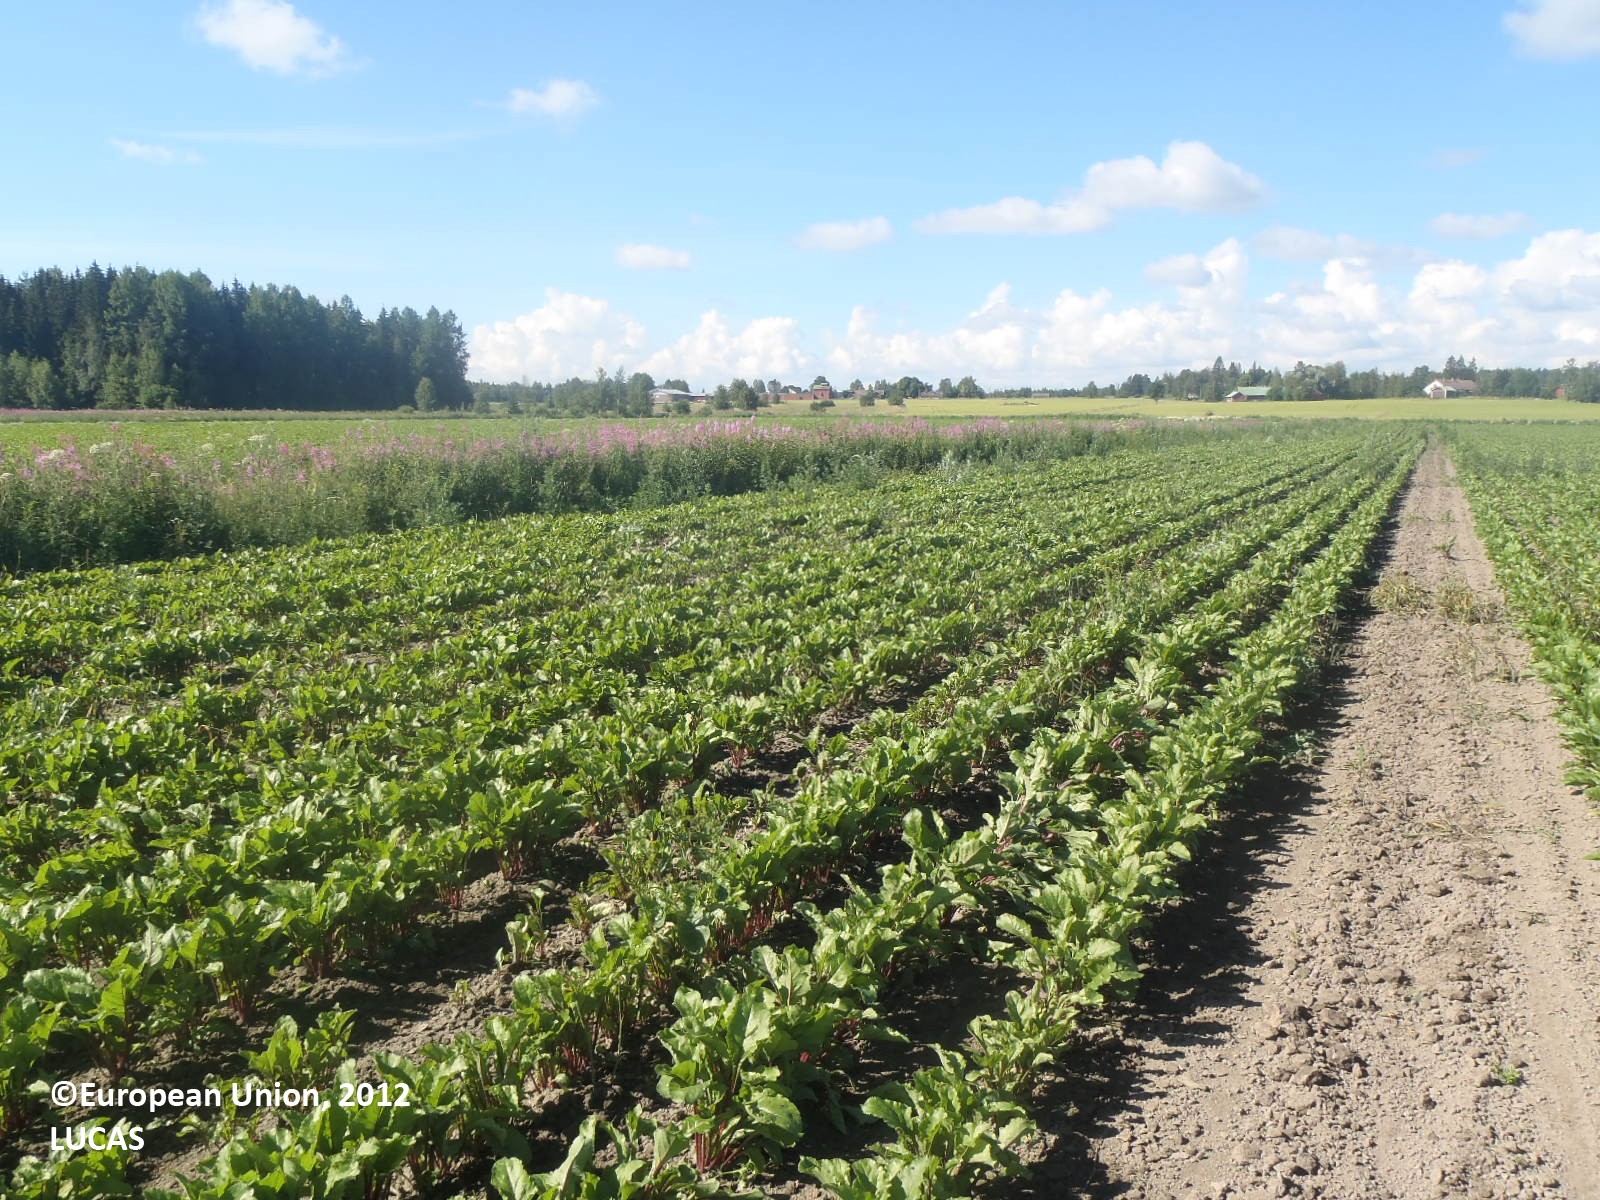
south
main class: Cropland
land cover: Other root crops
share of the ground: 50 - 75 %
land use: Agriculture (excluding fallow land and kitchen gardens)
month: July
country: FI
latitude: 61.0024
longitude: 21.9498
